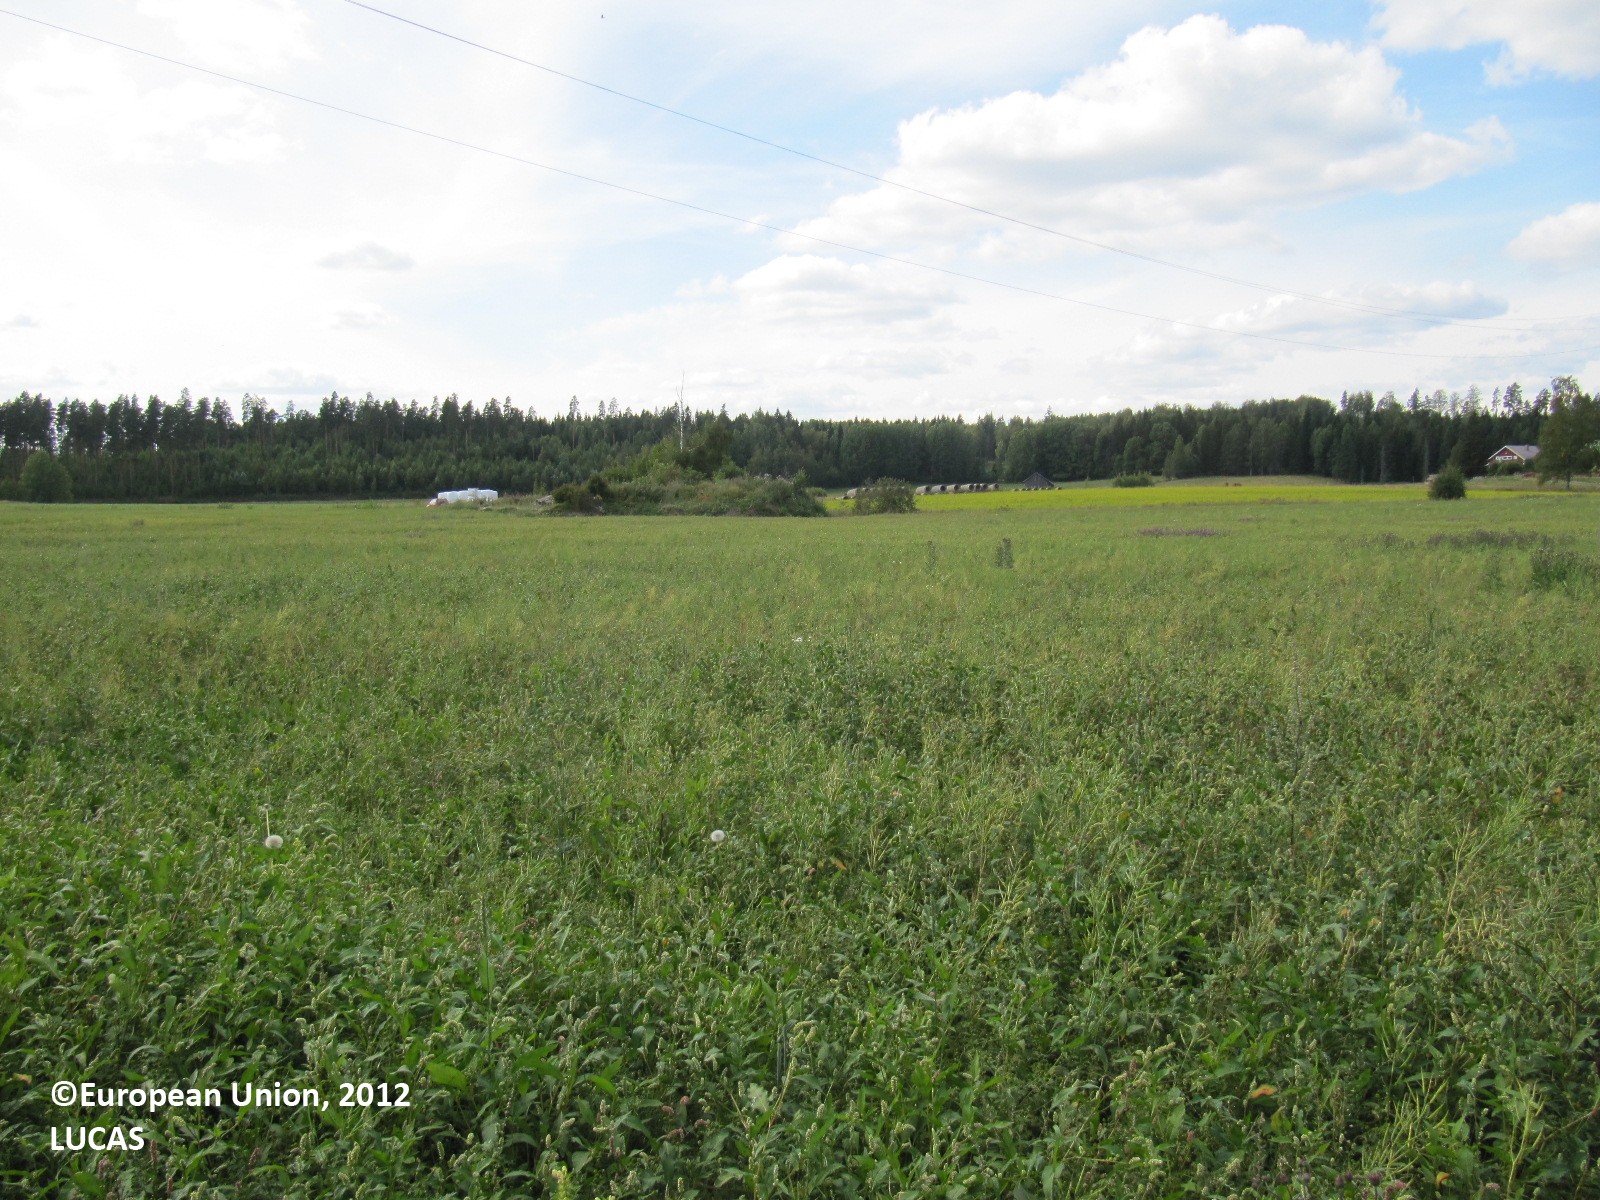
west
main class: Cropland
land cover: Dry pulses
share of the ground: > 75 %
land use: Agriculture (excluding fallow land and kitchen gardens)
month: August
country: FI
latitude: 60.3919
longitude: 24.3849
